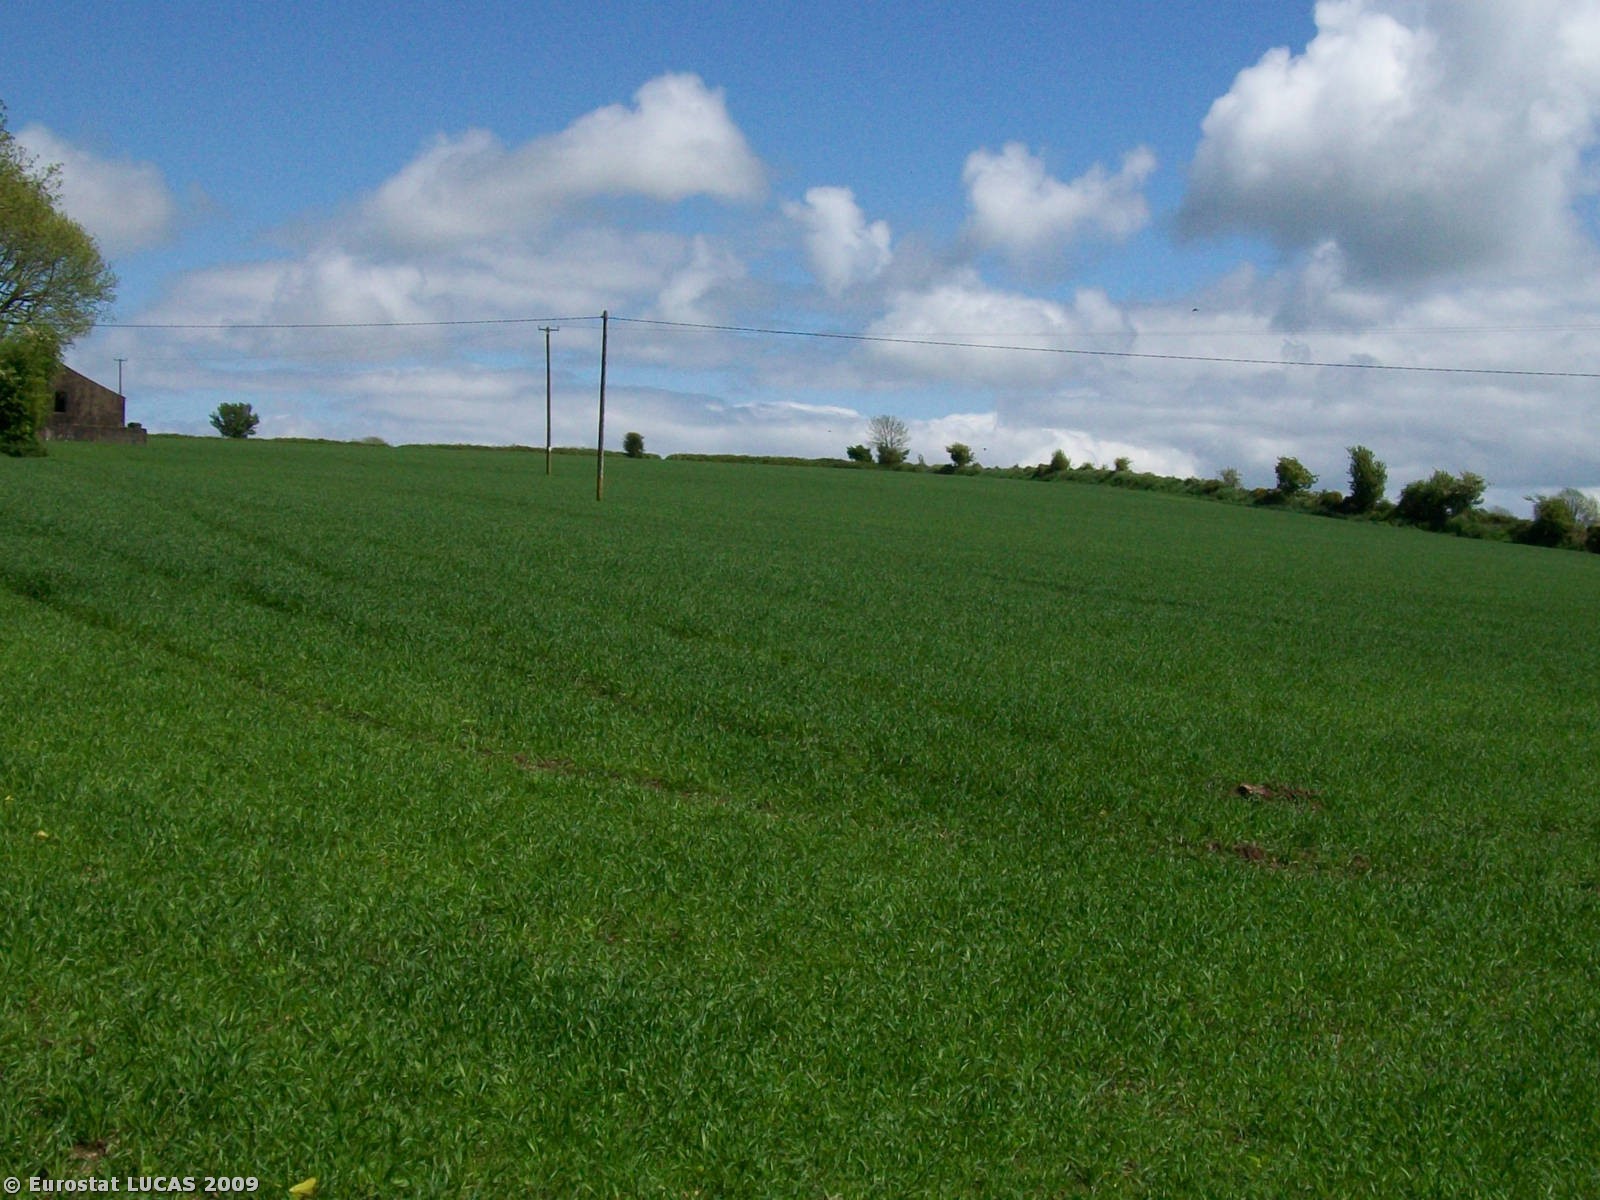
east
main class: Cropland
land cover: Common wheat
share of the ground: > 75 %
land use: Agriculture (excluding fallow land and kitchen gardens)
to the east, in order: Common wheat; Electric lines; Common wheat; Electric lines; Common wheat
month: May
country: IE
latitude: 51.8321
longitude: -8.7037
